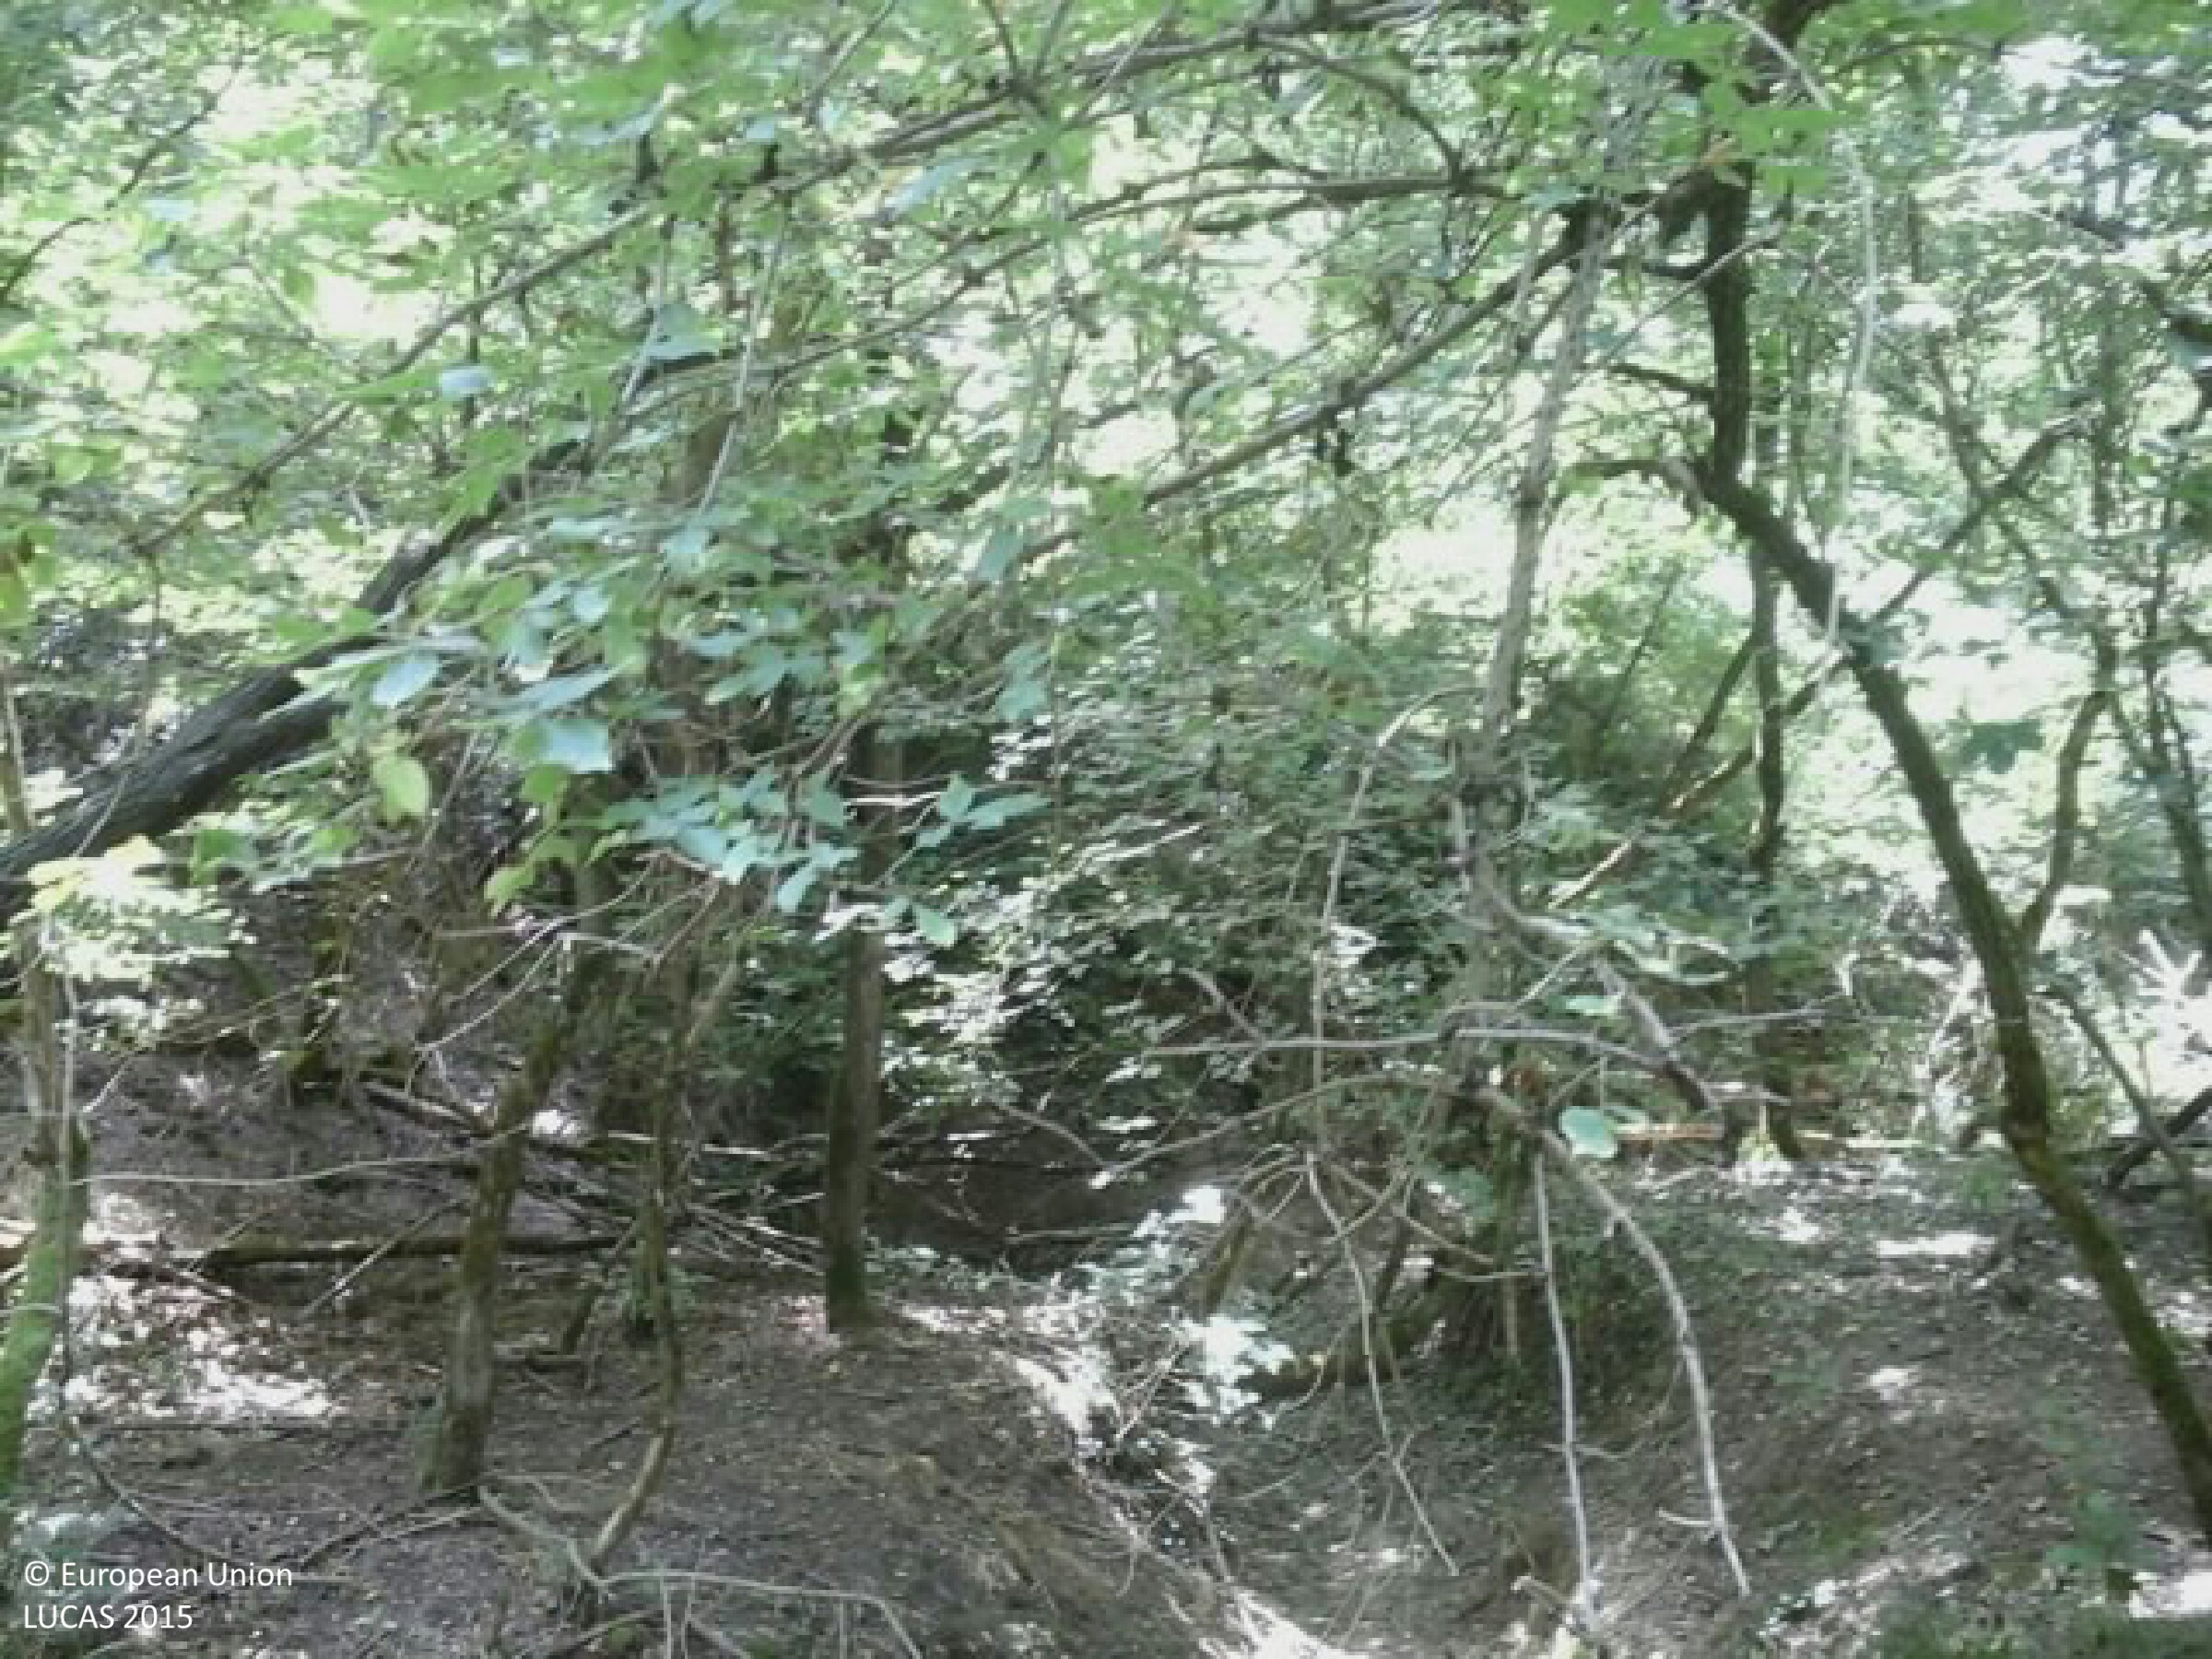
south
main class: Woodland
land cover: Broadleaved woodland
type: mesophytic deciduous forest
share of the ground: > 75 %
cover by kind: broadleaved forest trees 90 %, shrubs 5 %, herbaceous plants 5 %
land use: Forestry
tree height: > 5 m
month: July
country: HU
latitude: 46.3187
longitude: 17.0285
